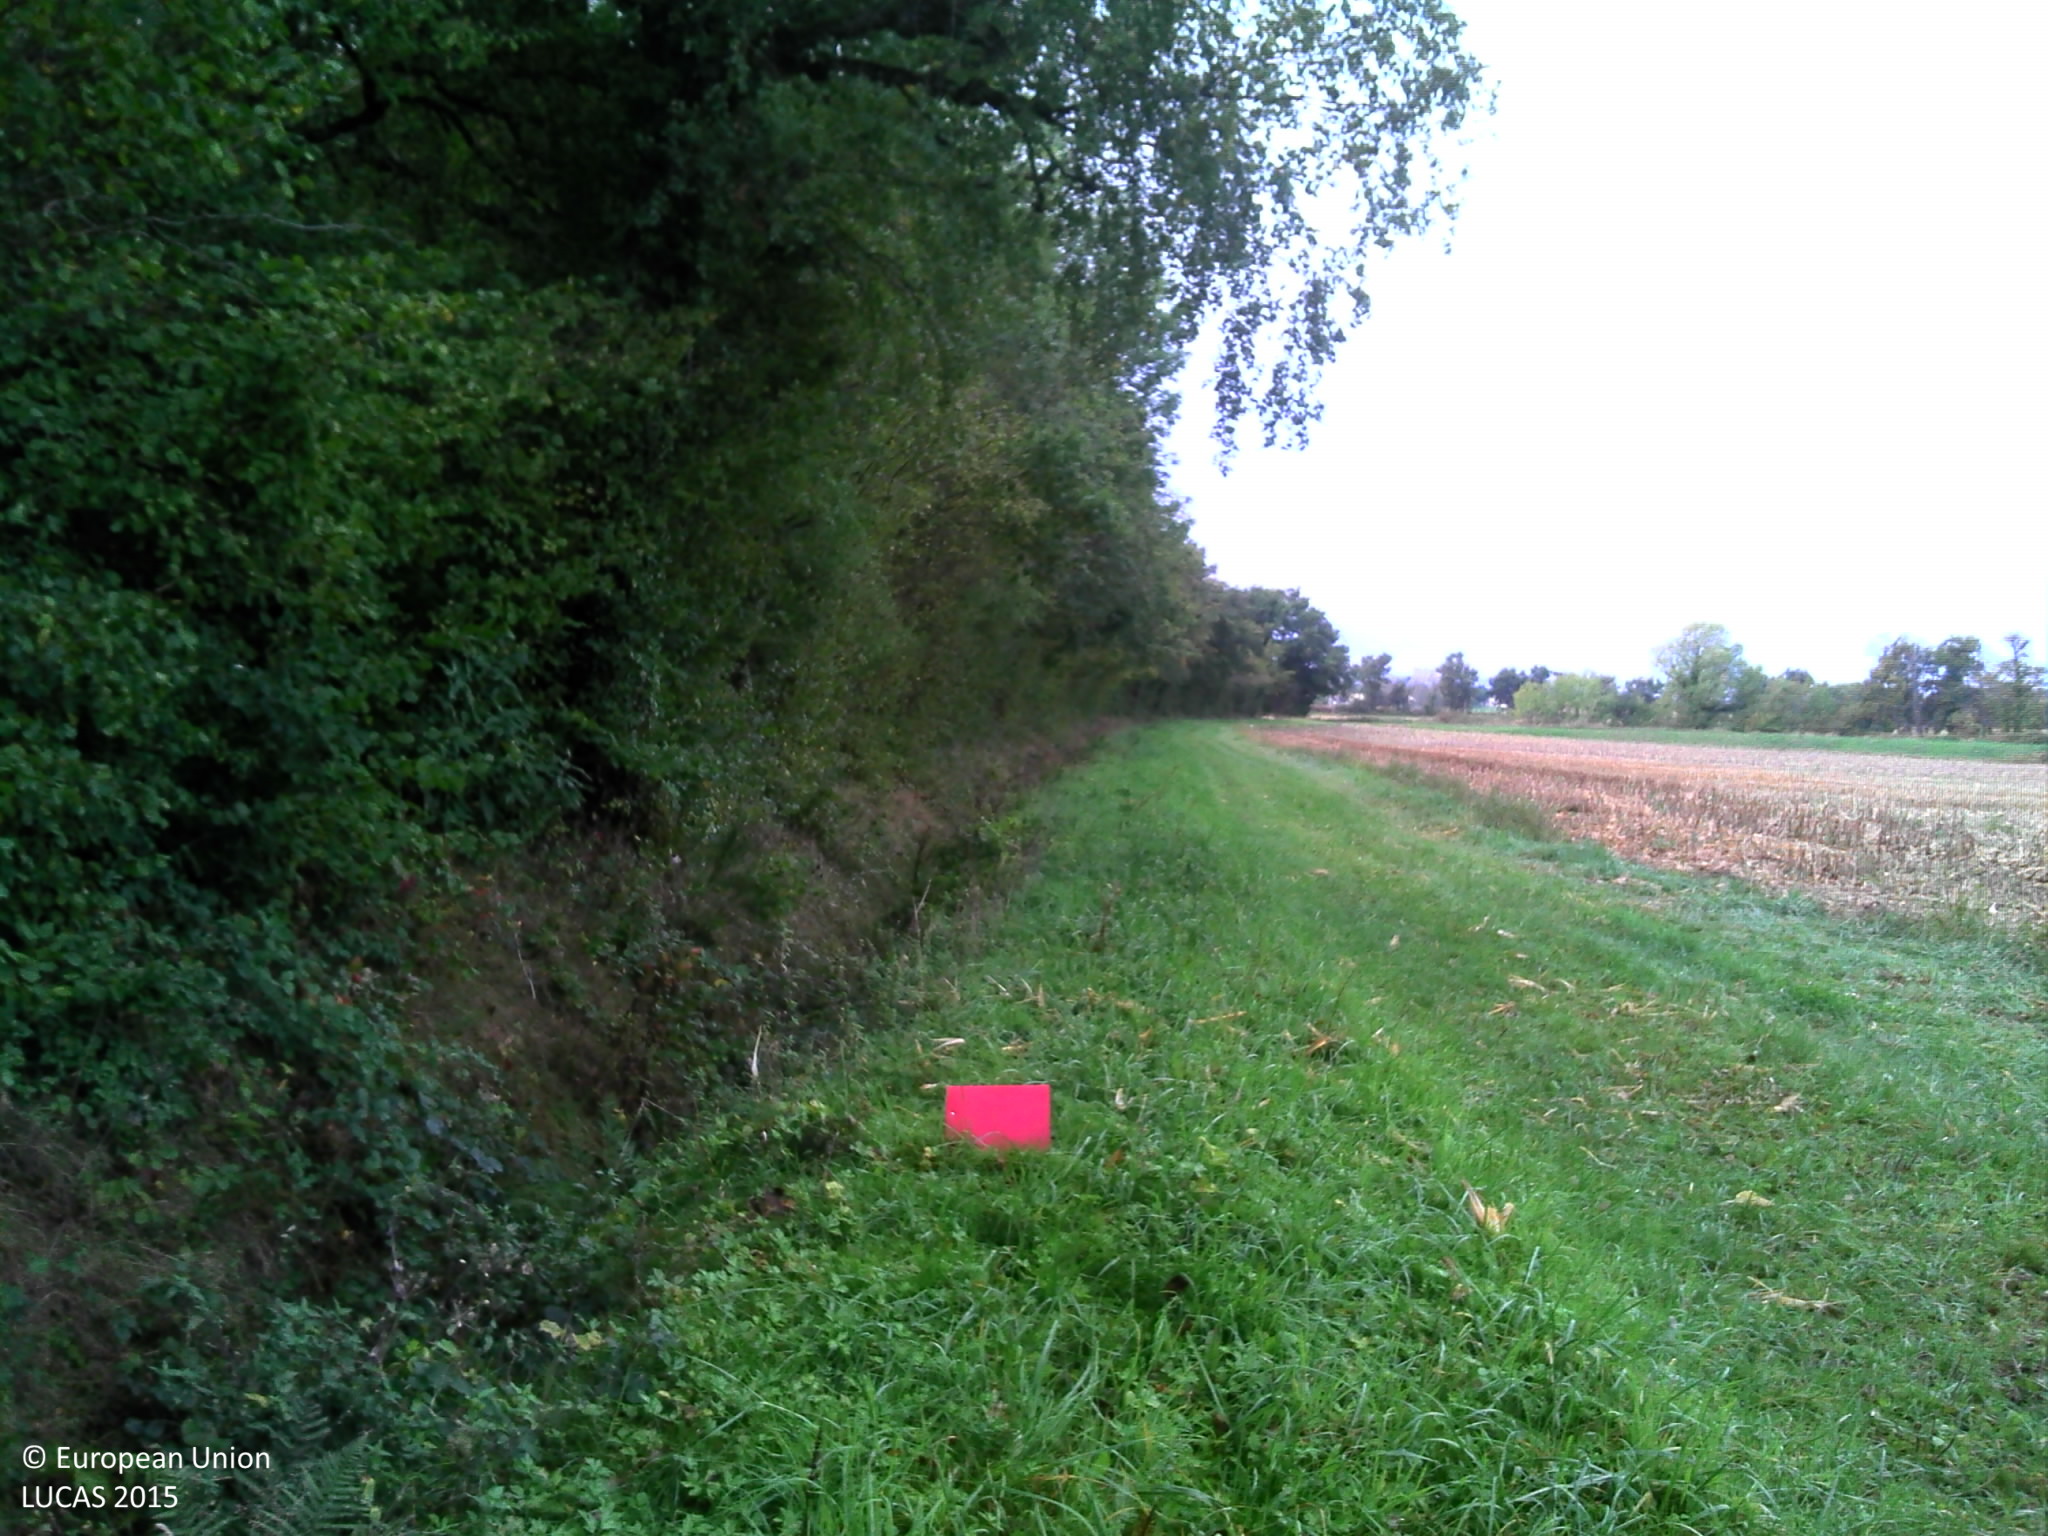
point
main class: Grassland
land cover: Grassland without tree/shrub cover
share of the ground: > 75 %
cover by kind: herbaceous plants 100 %
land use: Agriculture (excluding fallow land and kitchen gardens)
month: October
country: FR
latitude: 45.8730
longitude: 4.9920
